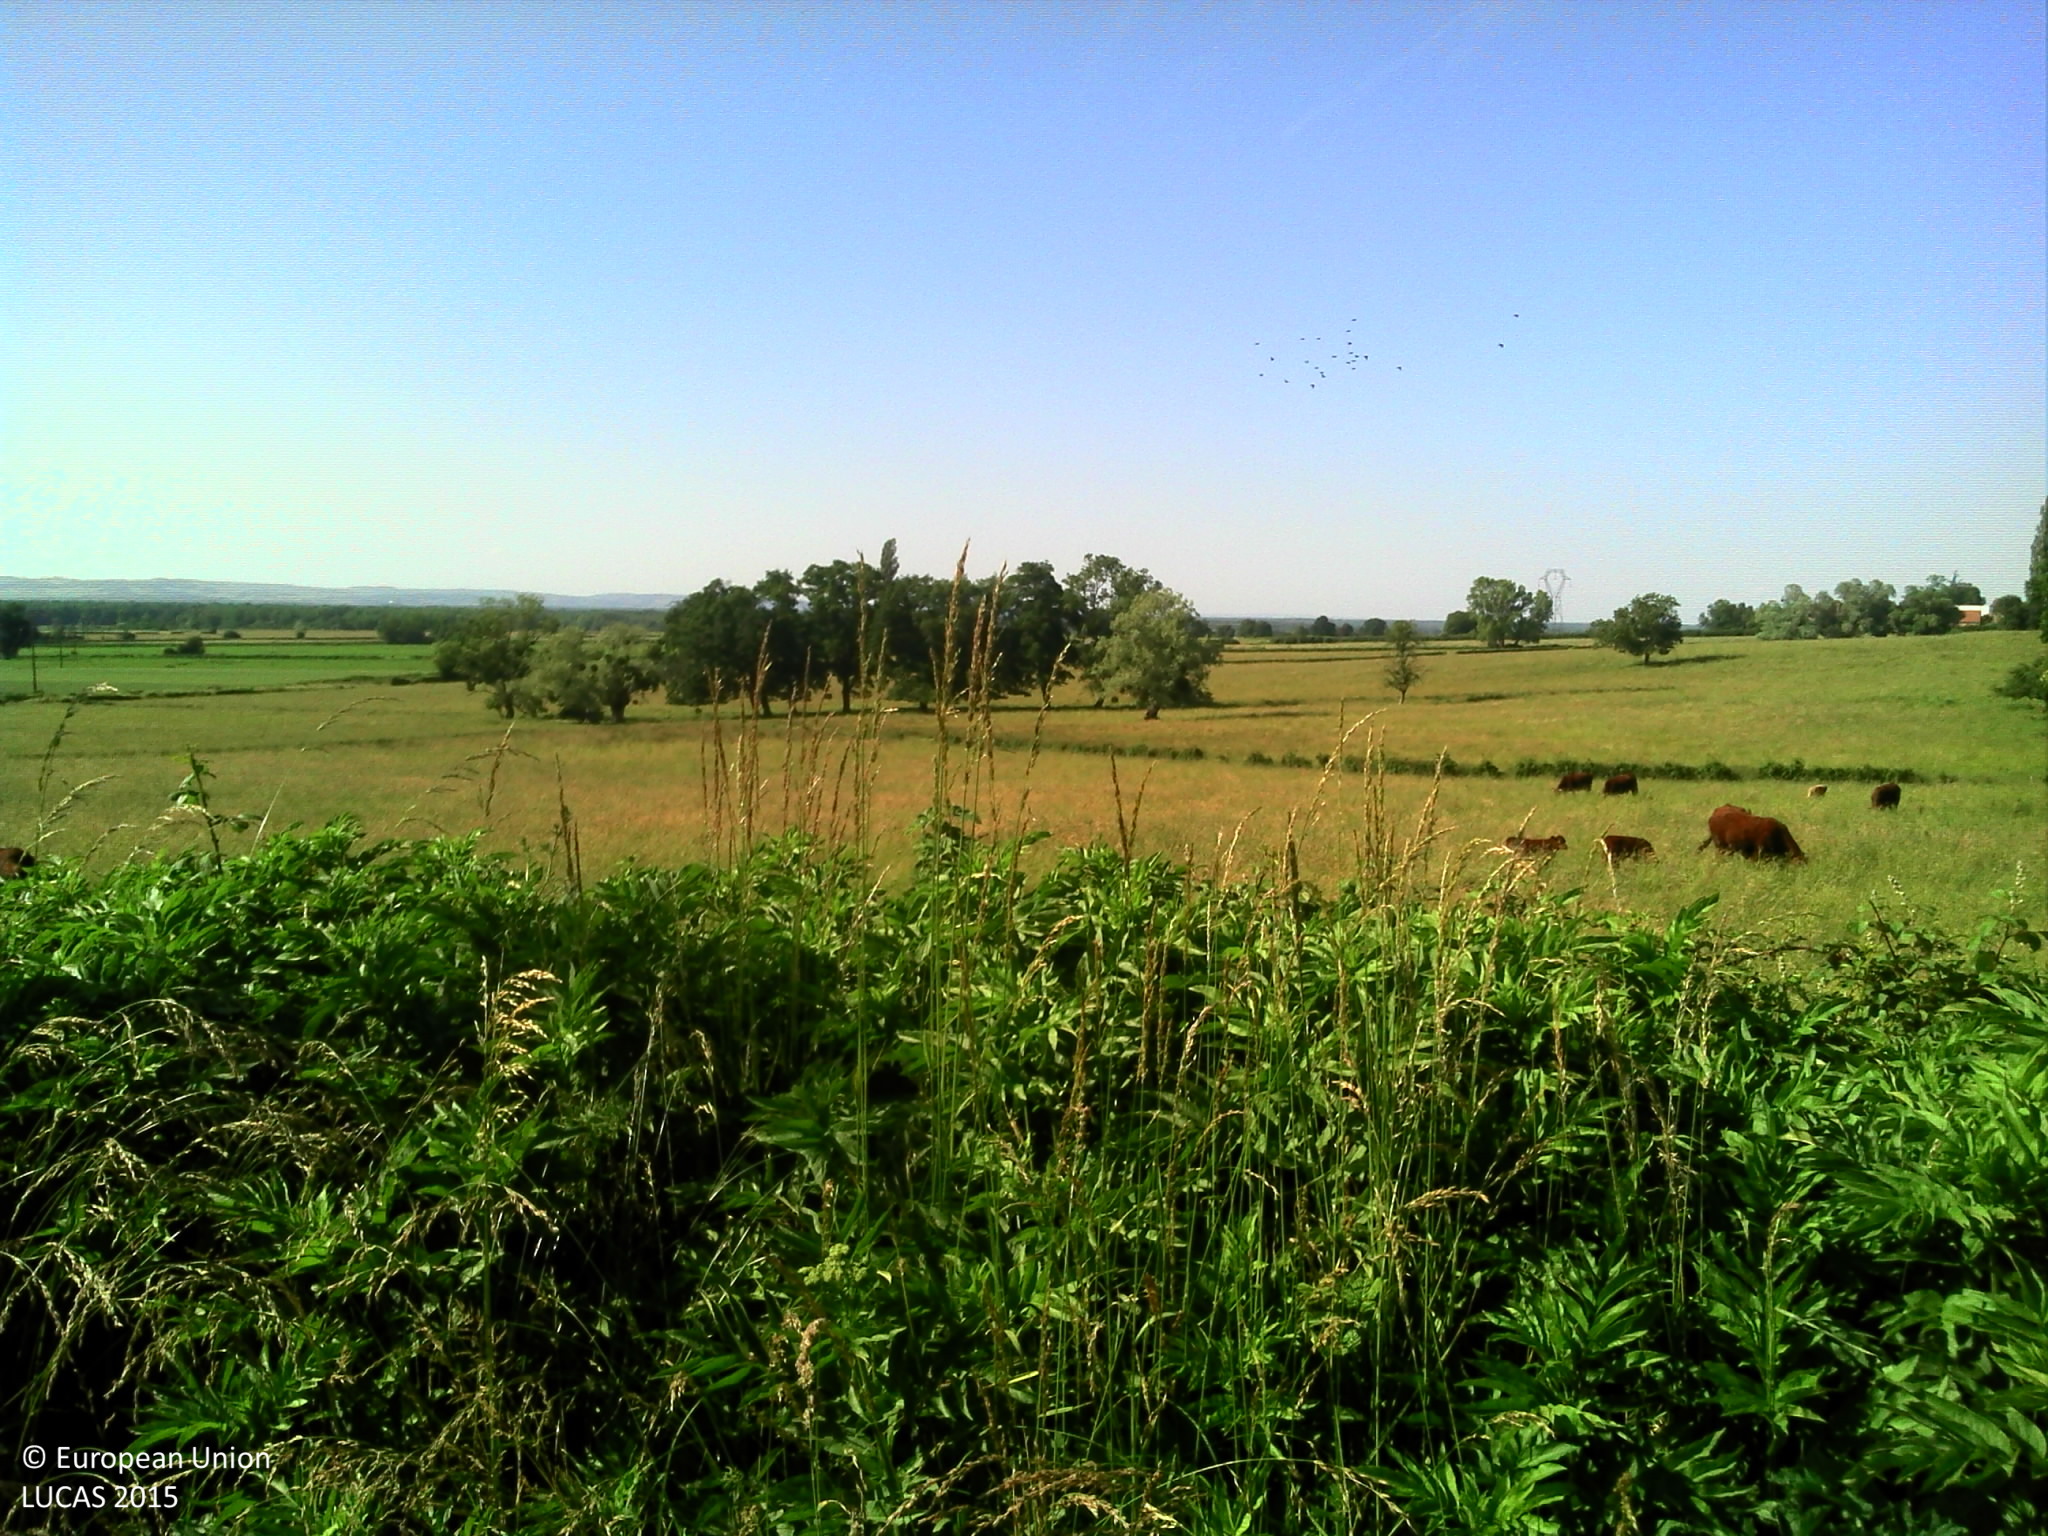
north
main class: Grassland
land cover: Grassland without tree/shrub cover
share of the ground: > 75 %
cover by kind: herbaceous plants 85 %, unconsolidated bare surface 15 %
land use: Agriculture (excluding fallow land and kitchen gardens)
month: June
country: FR
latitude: 46.5854
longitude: 4.7944
